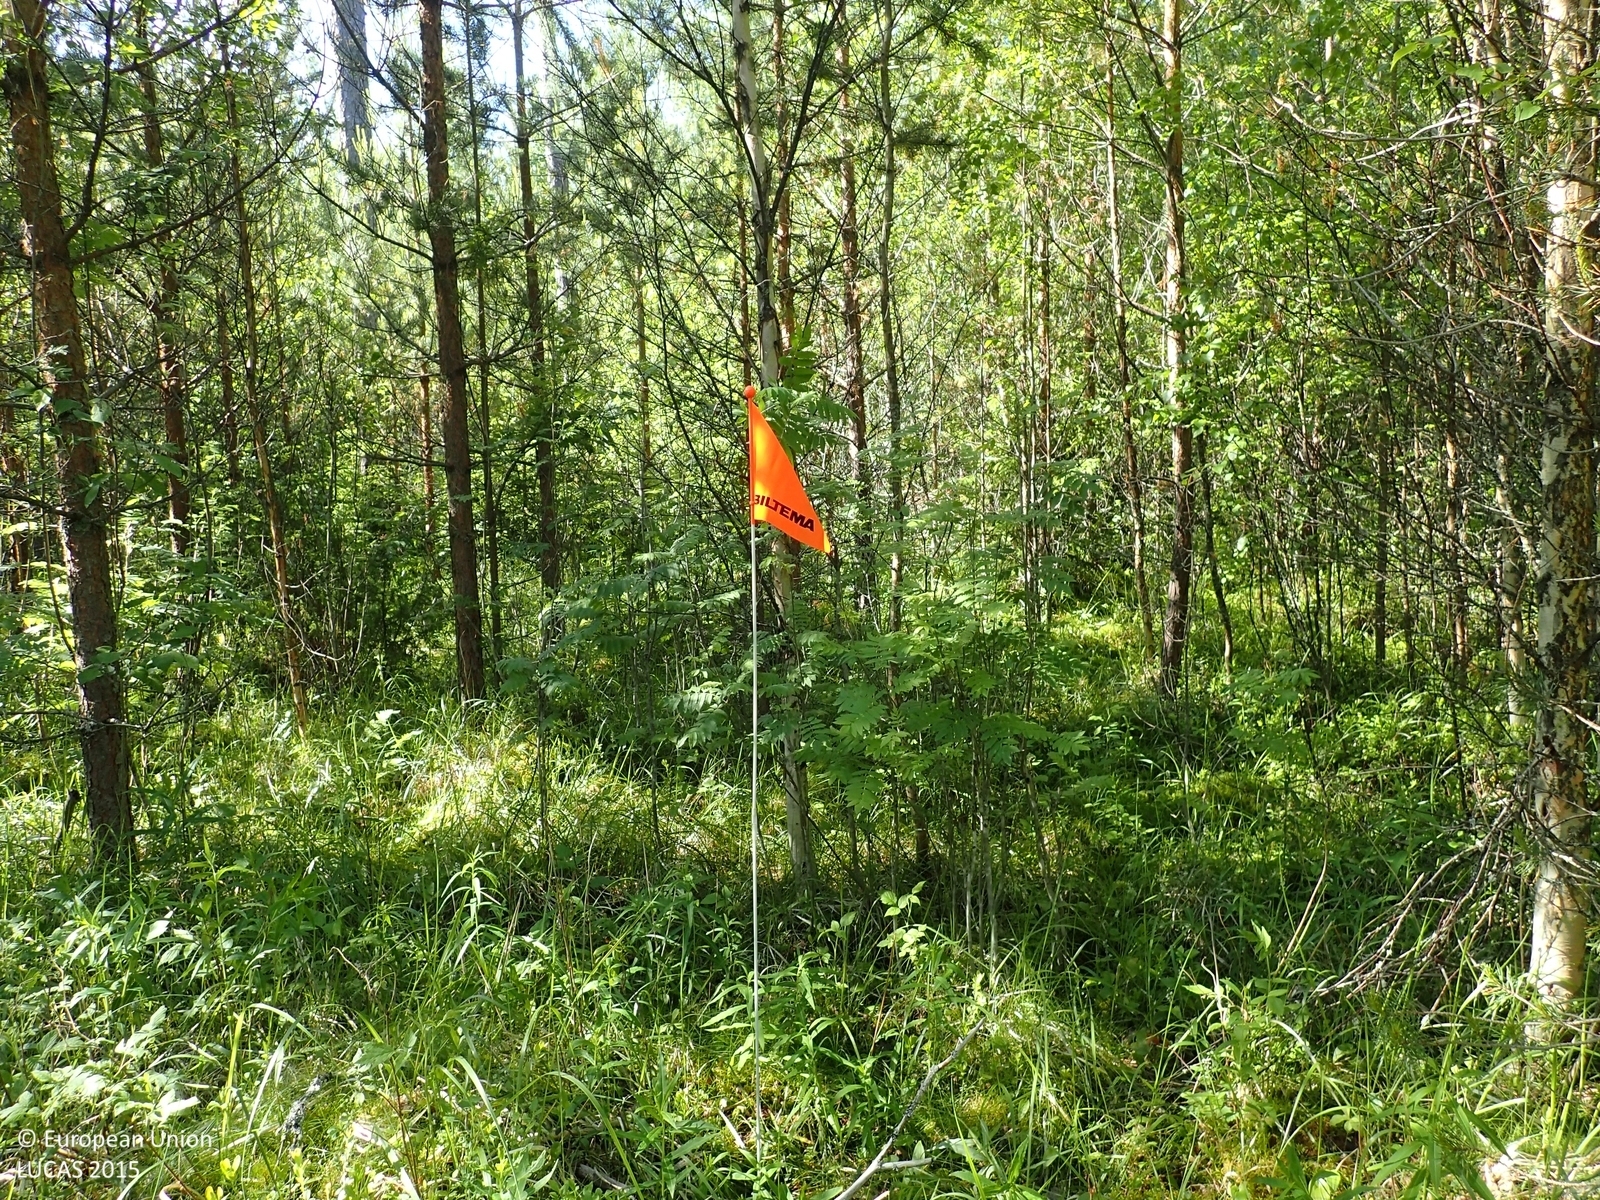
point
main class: Woodland
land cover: Pine dominated mixed woodland
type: boreal forest
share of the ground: > 75 %
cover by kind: coniferous forest trees 60 %, broadleaved forest trees 25 %, herbaceous plants 15 %
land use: Forestry
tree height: > 5 m
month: June
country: FI
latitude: 62.4000
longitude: 21.3611
